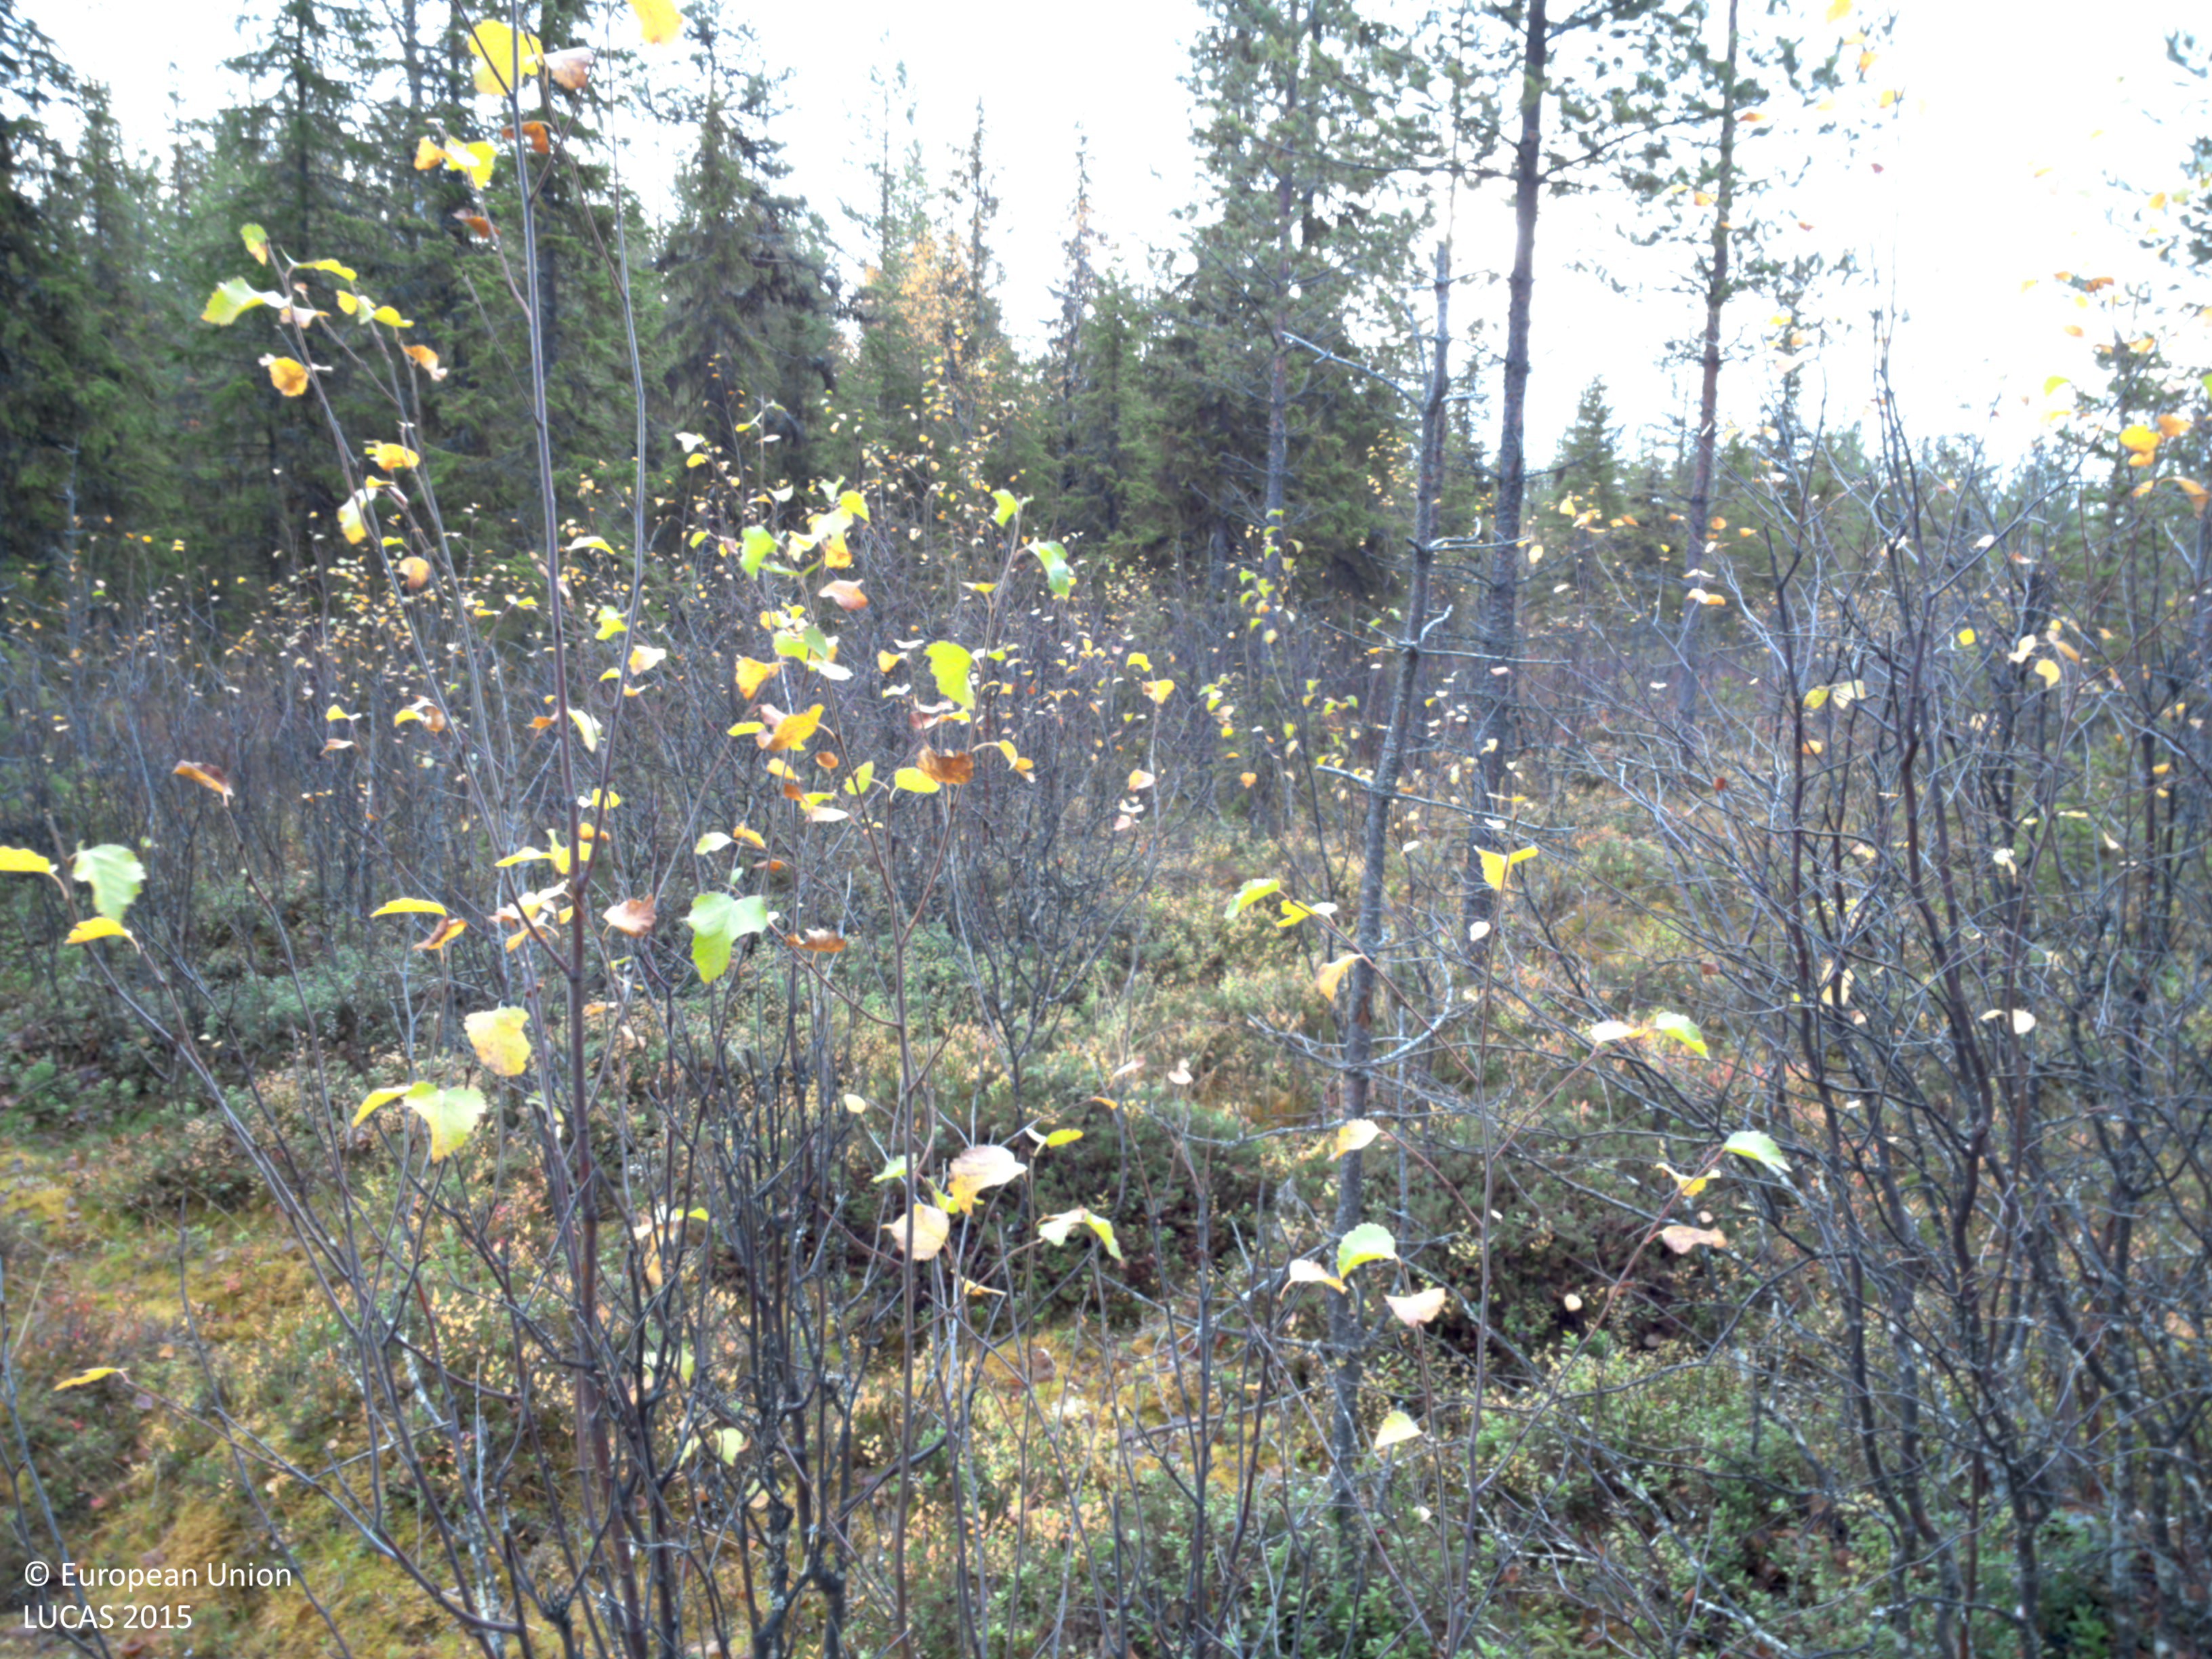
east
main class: Woodland
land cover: Pine dominated mixed woodland
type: boreal forest
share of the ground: 50 - 75 %
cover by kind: coniferous forest trees 45 %, shrubs 35 %, broadleaved forest trees 15 %, lichens and mosses 5 %
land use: Forestry
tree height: > 5 m
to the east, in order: Pine dominated mixed woodland; Spruce dominated coniferous woodland; Other coniferous woodland; Pine dominated coniferous woodland; Pine dominated mixed woodland; Spruce dominated mixed woodland
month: October
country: SE
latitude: 64.9788
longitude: 18.3342
